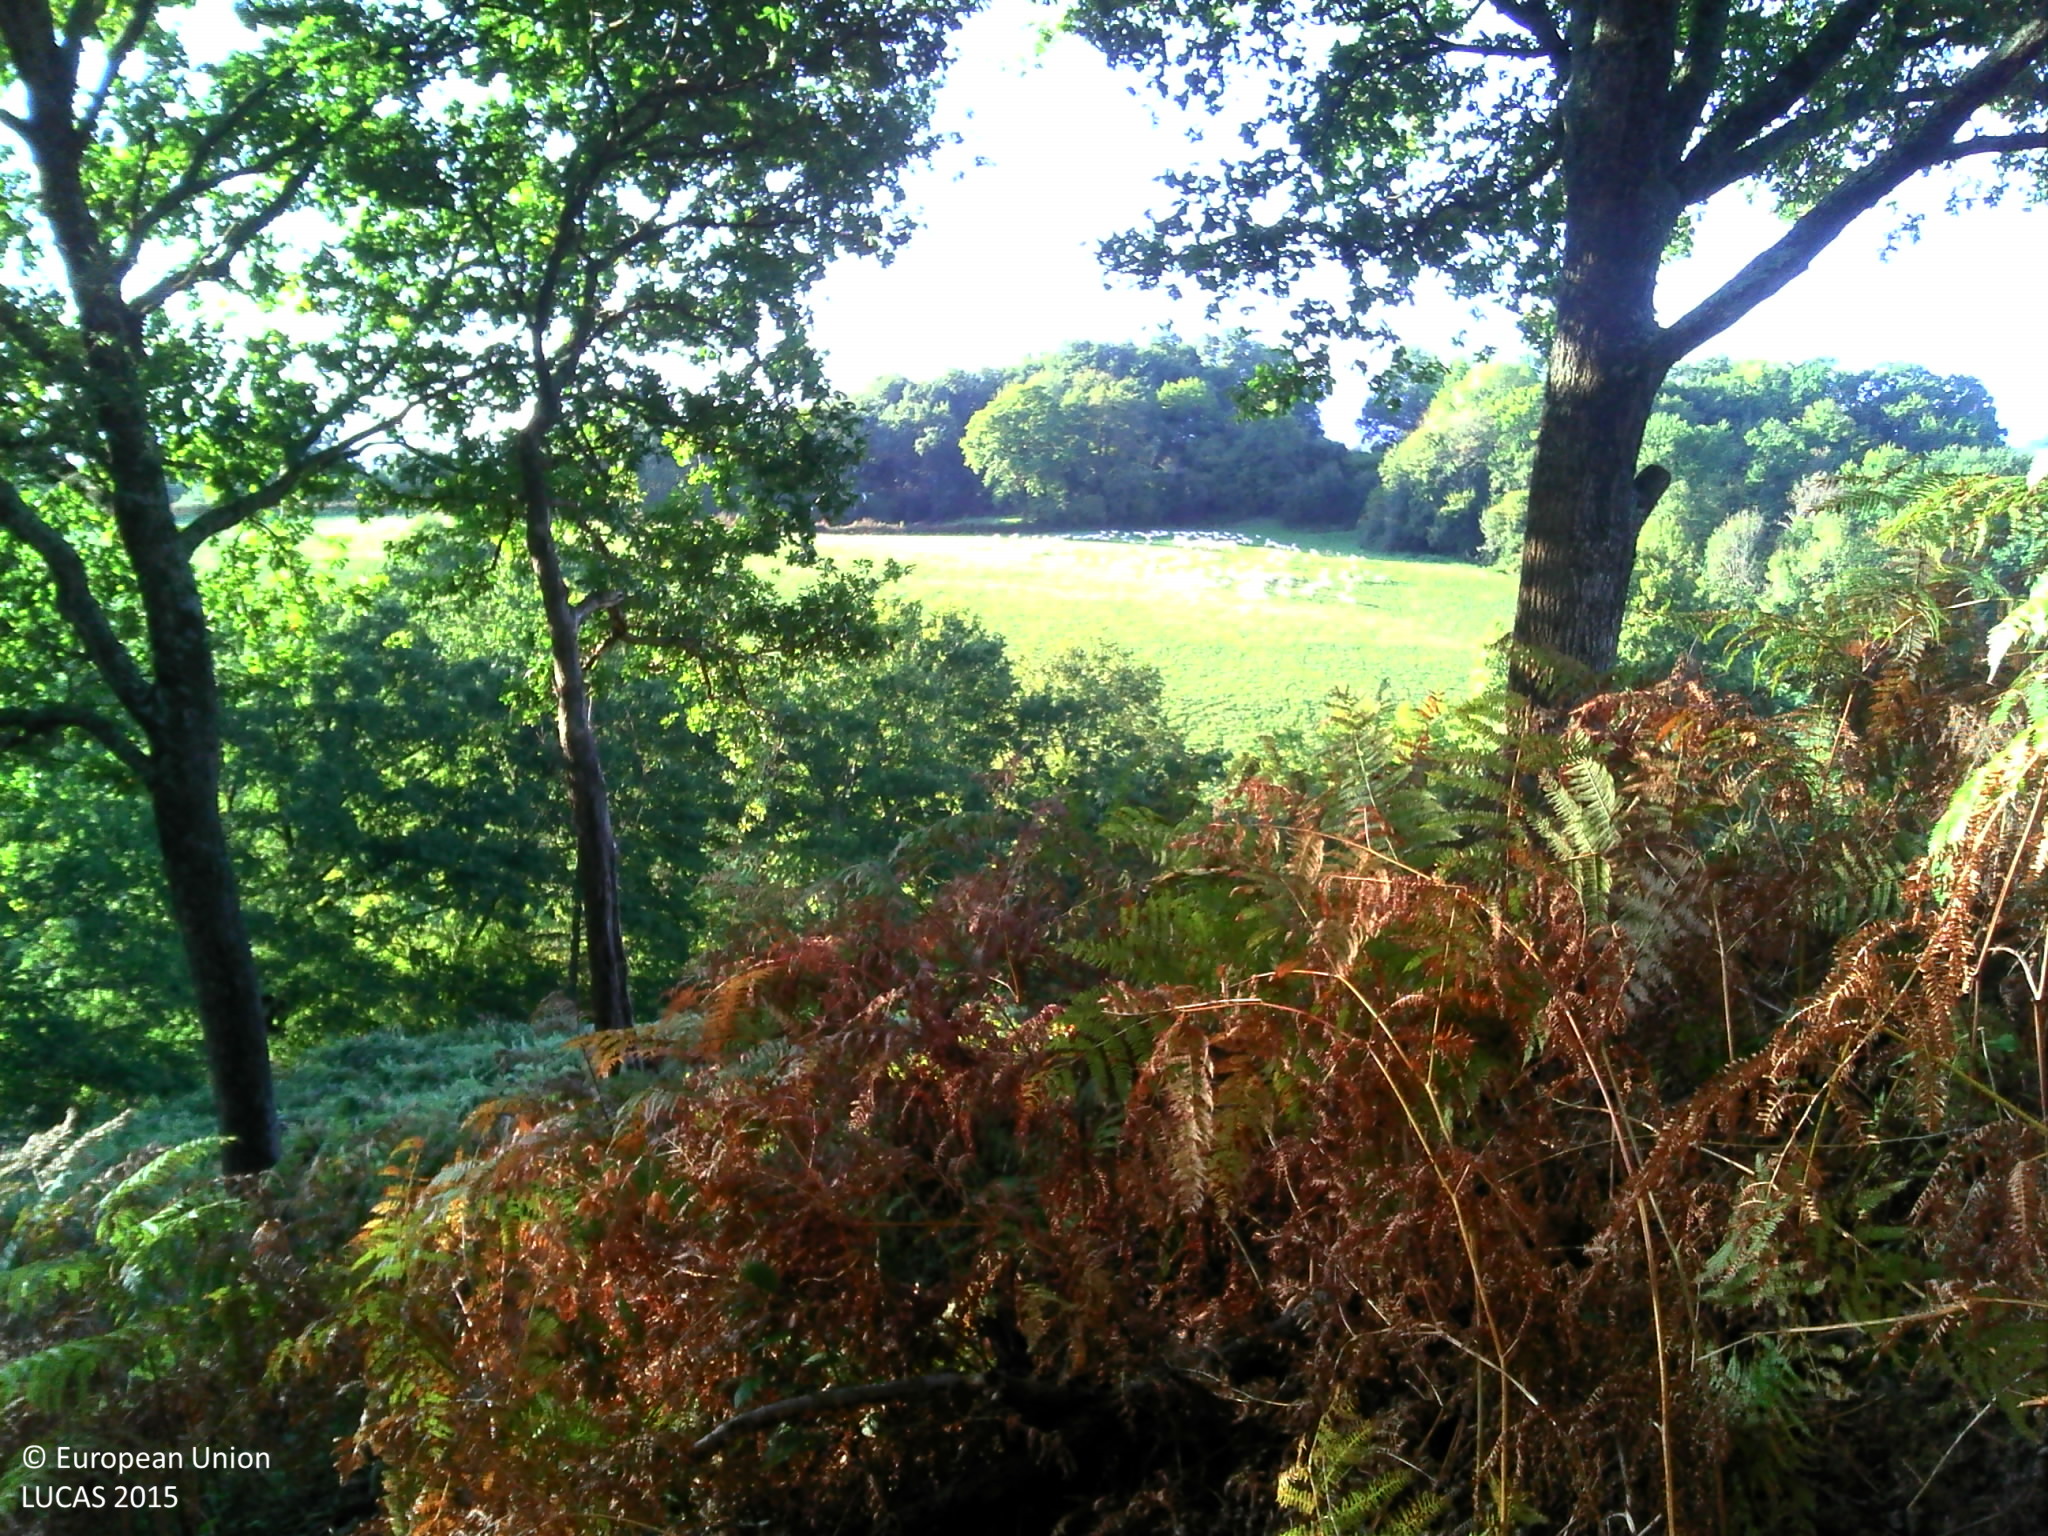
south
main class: Woodland
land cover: Broadleaved woodland
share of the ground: 50 - 75 %
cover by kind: broadleaved forest trees 65 %, herbaceous plants 20 %, shrubs 10 %, lichens and mosses 5 %
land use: Forestry
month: September
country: FR
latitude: 43.1979
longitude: -0.6781
